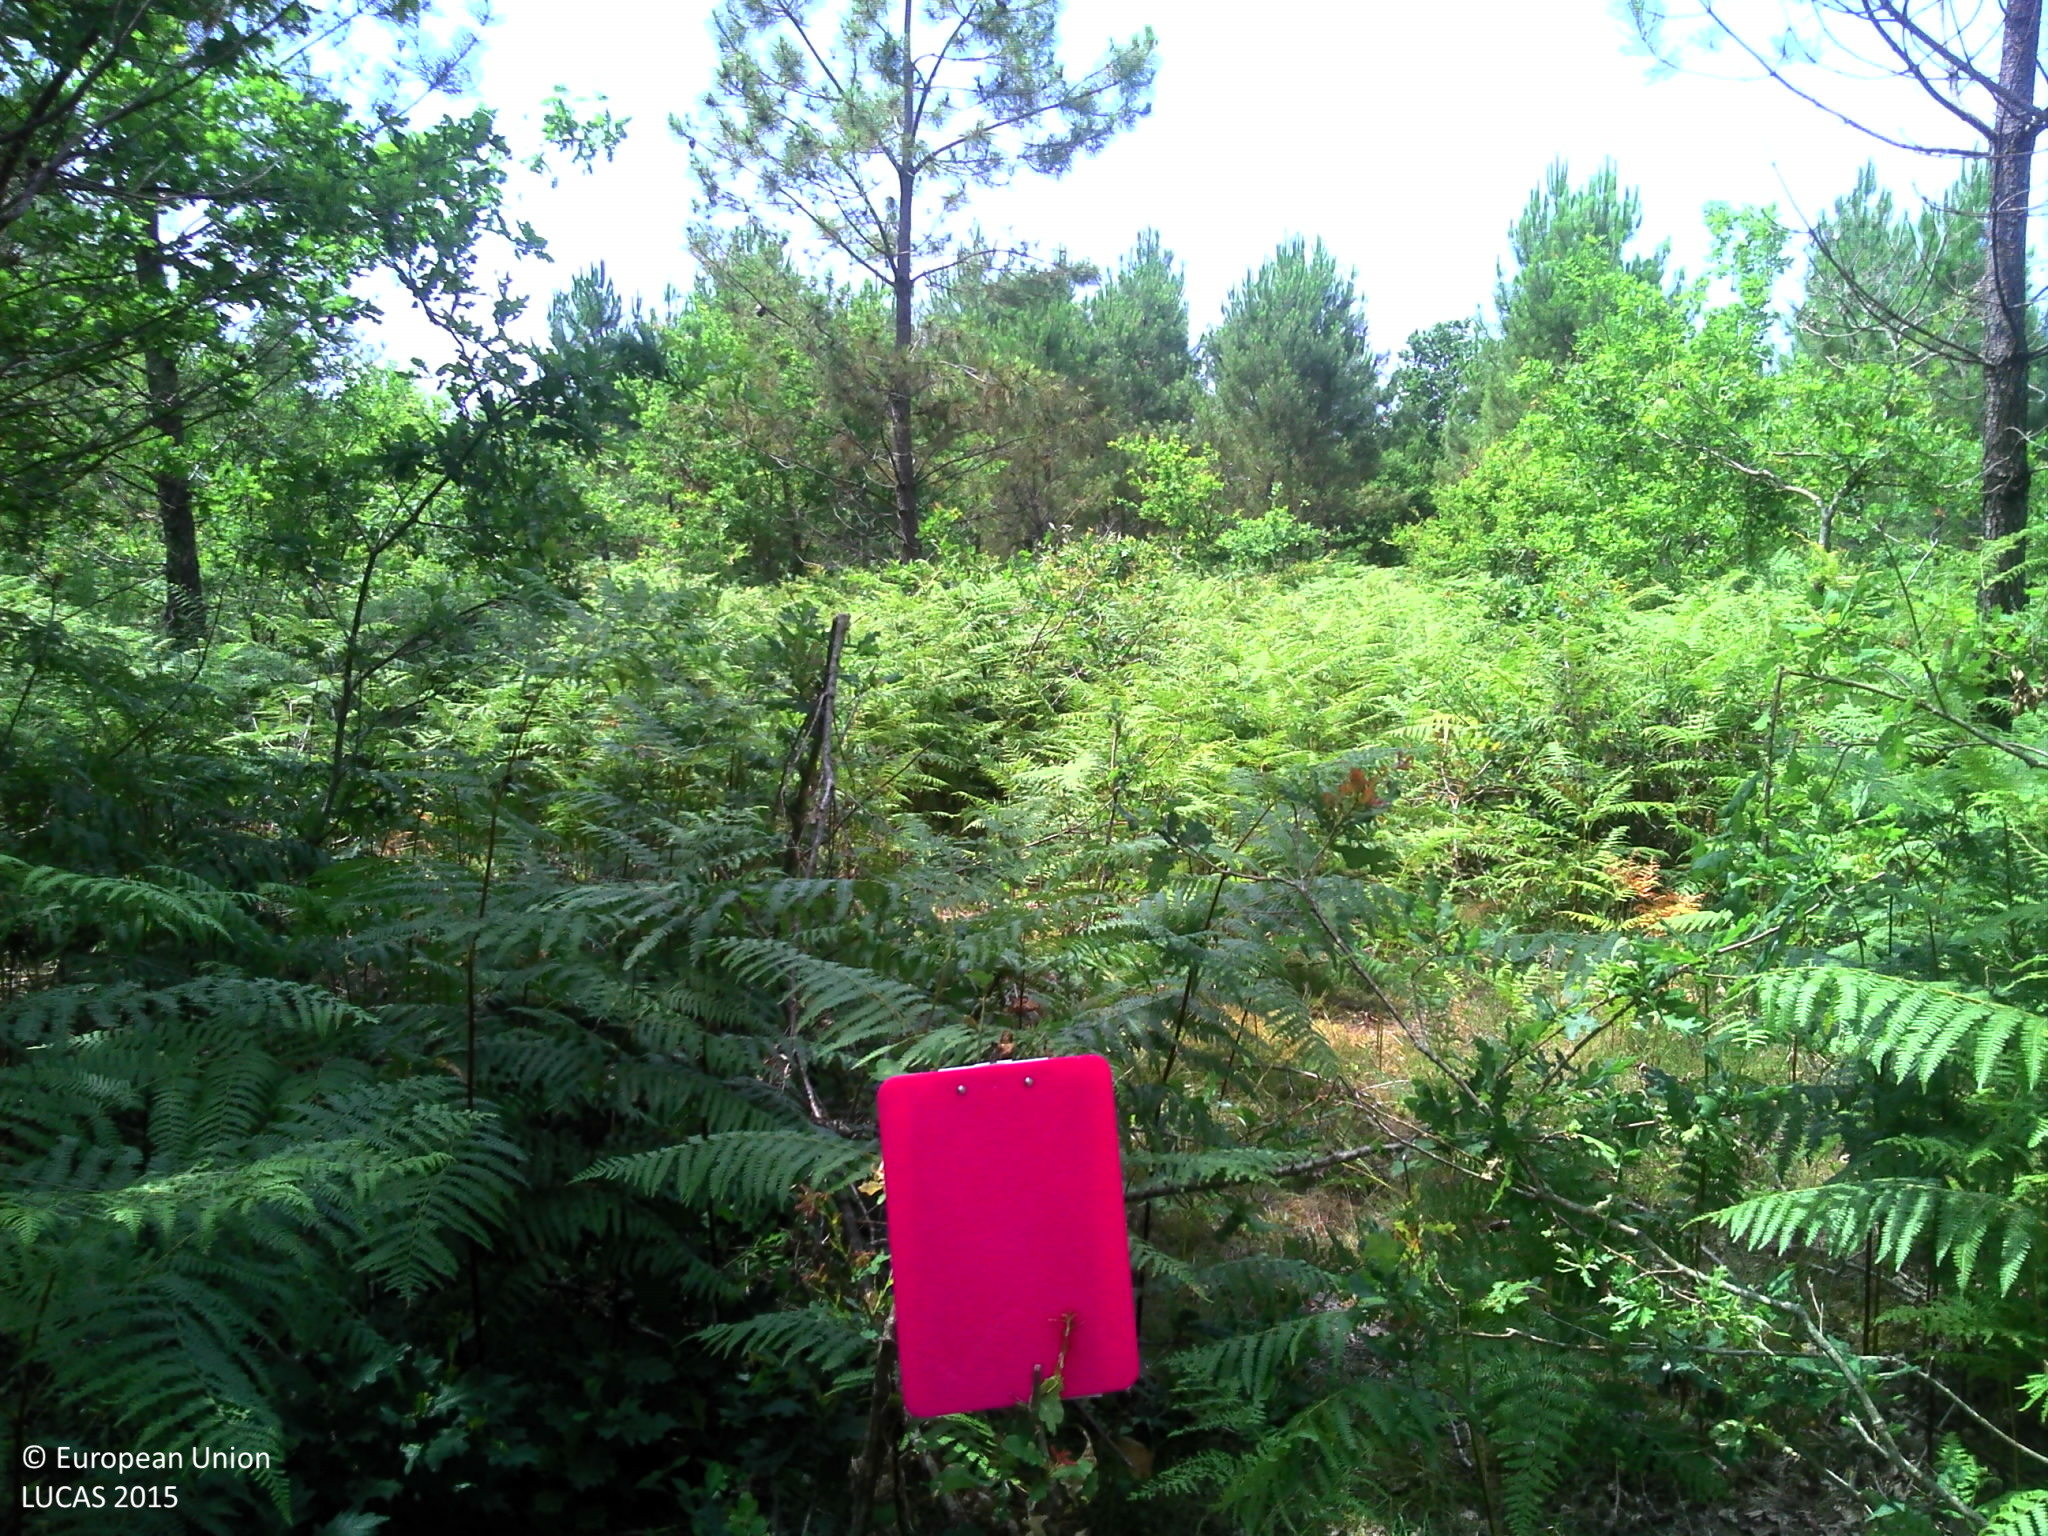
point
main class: Woodland
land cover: Pine dominated mixed woodland
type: coniferous forest of the mediterranean region
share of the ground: > 75 %
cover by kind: herbaceous plants 40 %, coniferous forest trees 30 %, broadleaved forest trees 25 %, shrubs 5 %
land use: Forestry
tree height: < 5 m
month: July
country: FR
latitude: 43.8539
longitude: -1.1770
